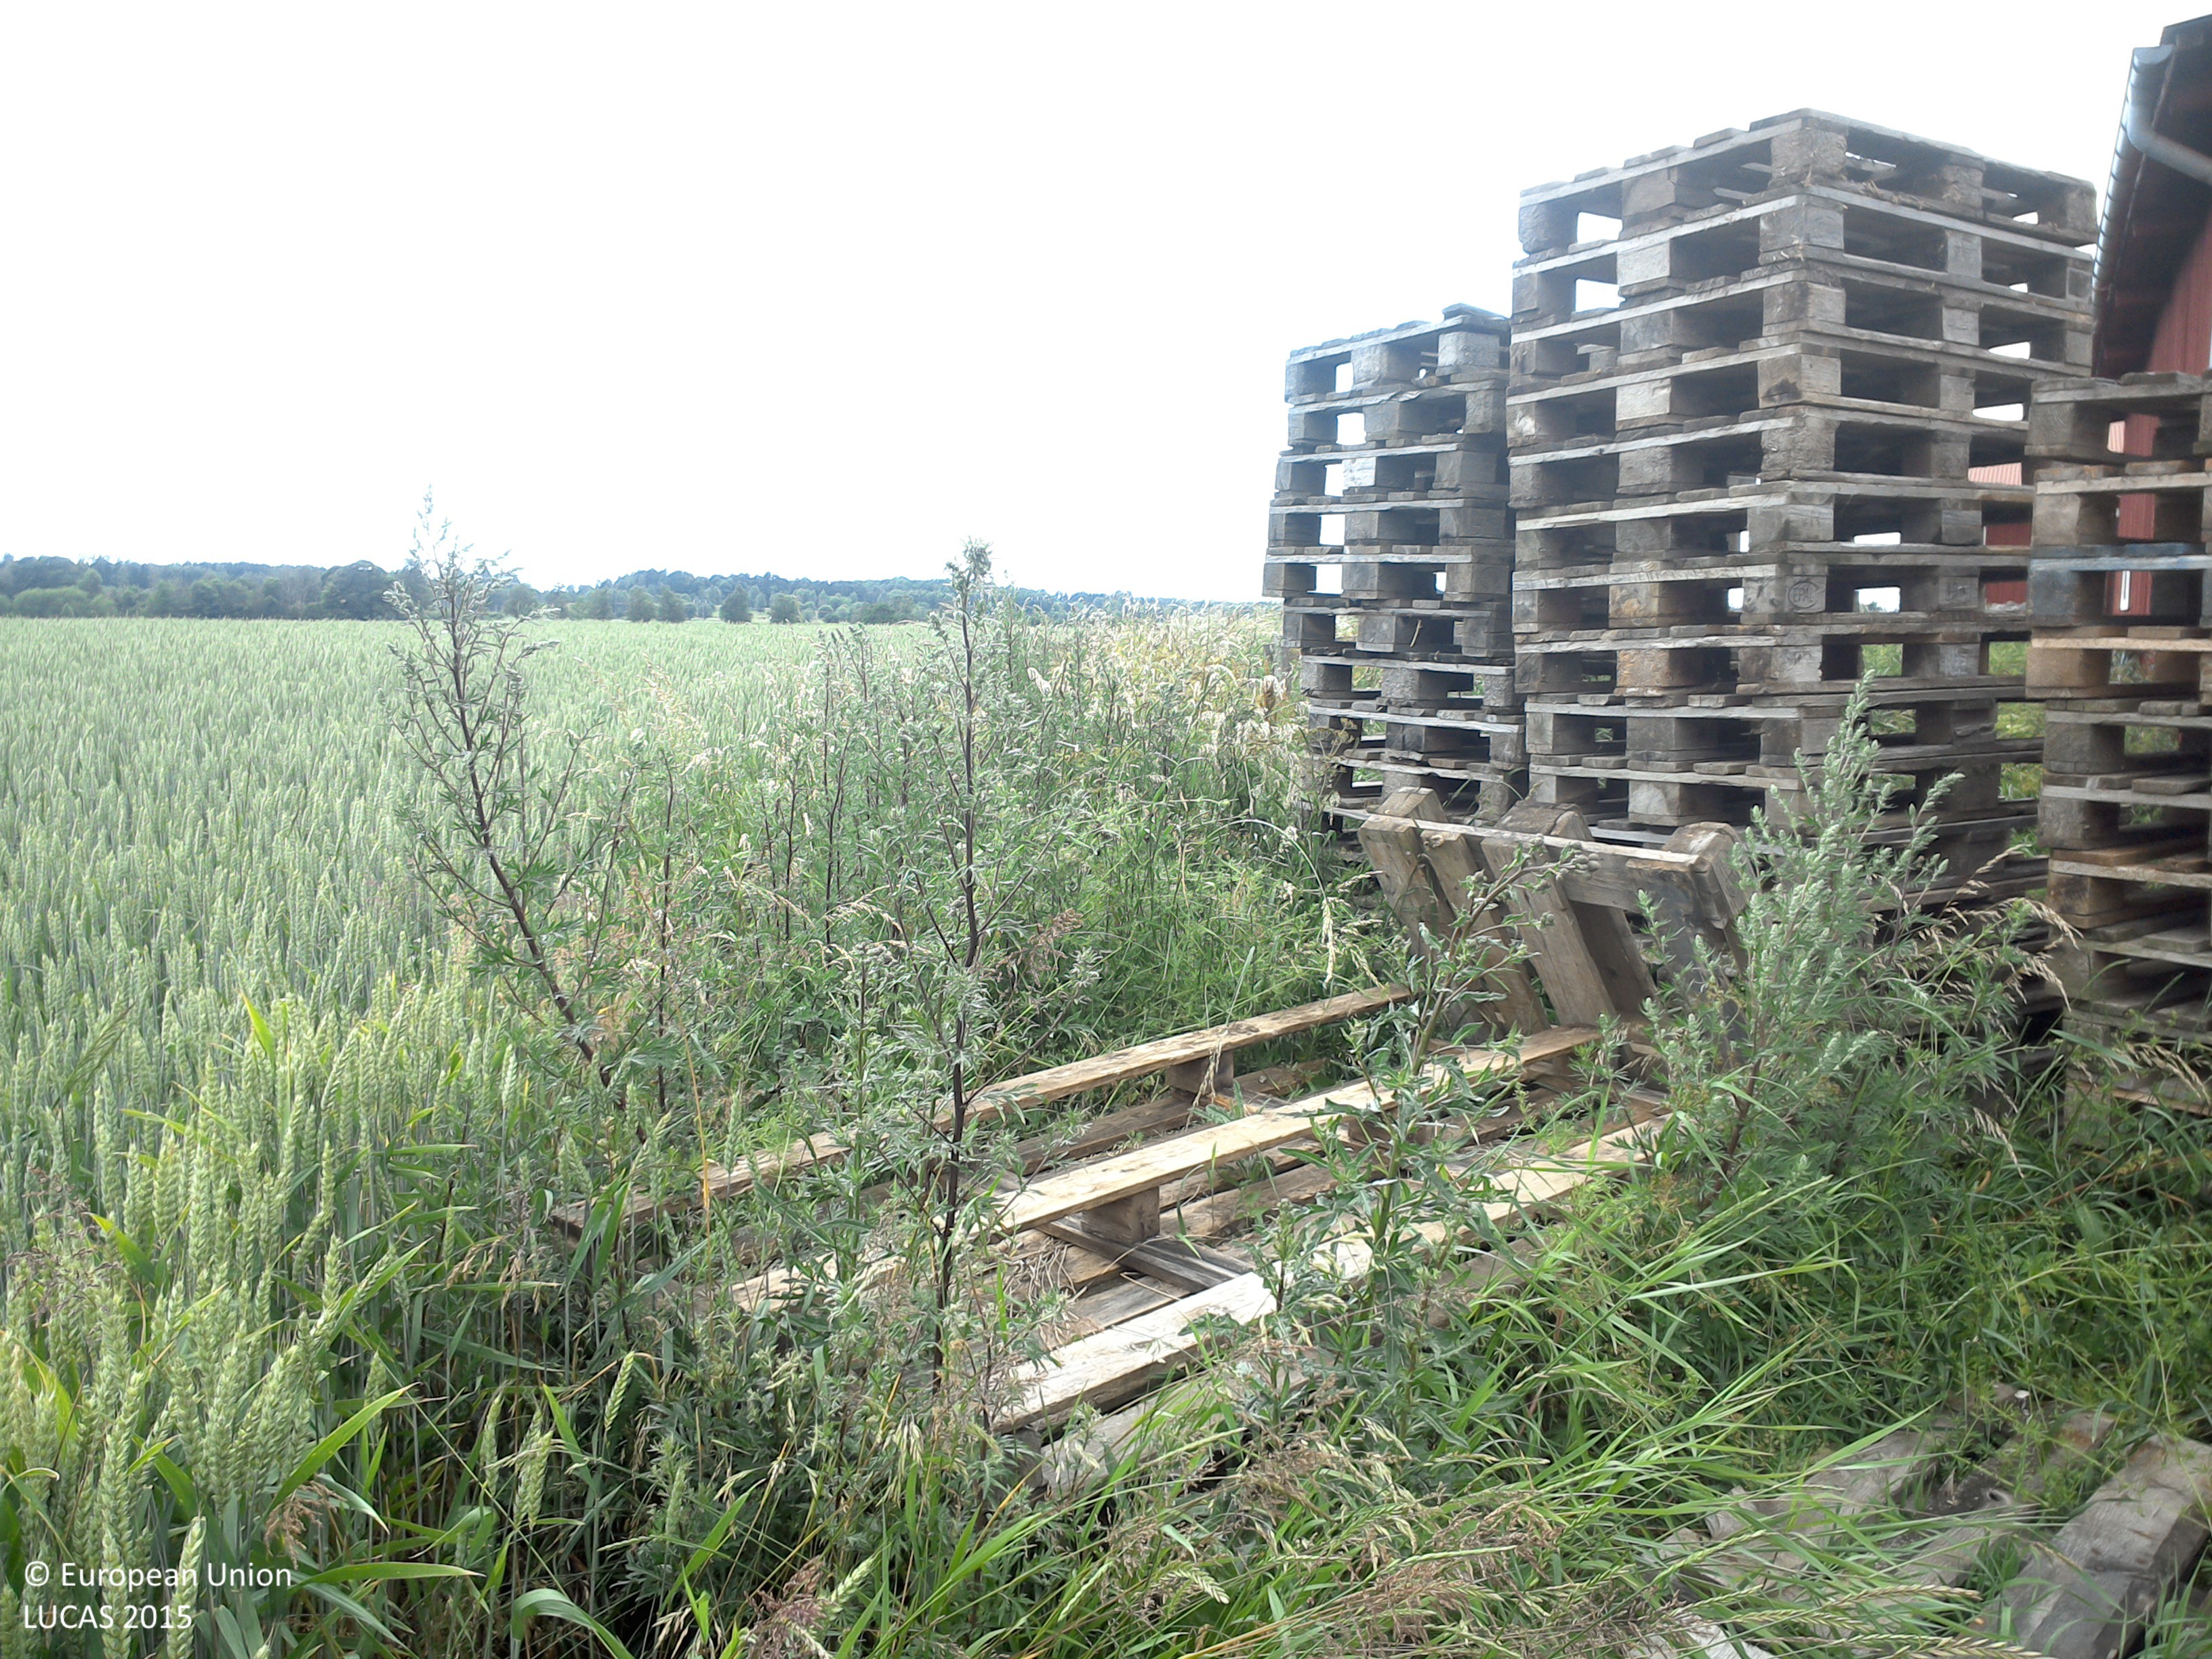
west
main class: Cropland
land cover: Common wheat
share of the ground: > 75 %
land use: Agriculture (excluding fallow land and kitchen gardens)
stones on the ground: < 10 %
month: July
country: SE
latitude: 58.5018
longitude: 15.0903
